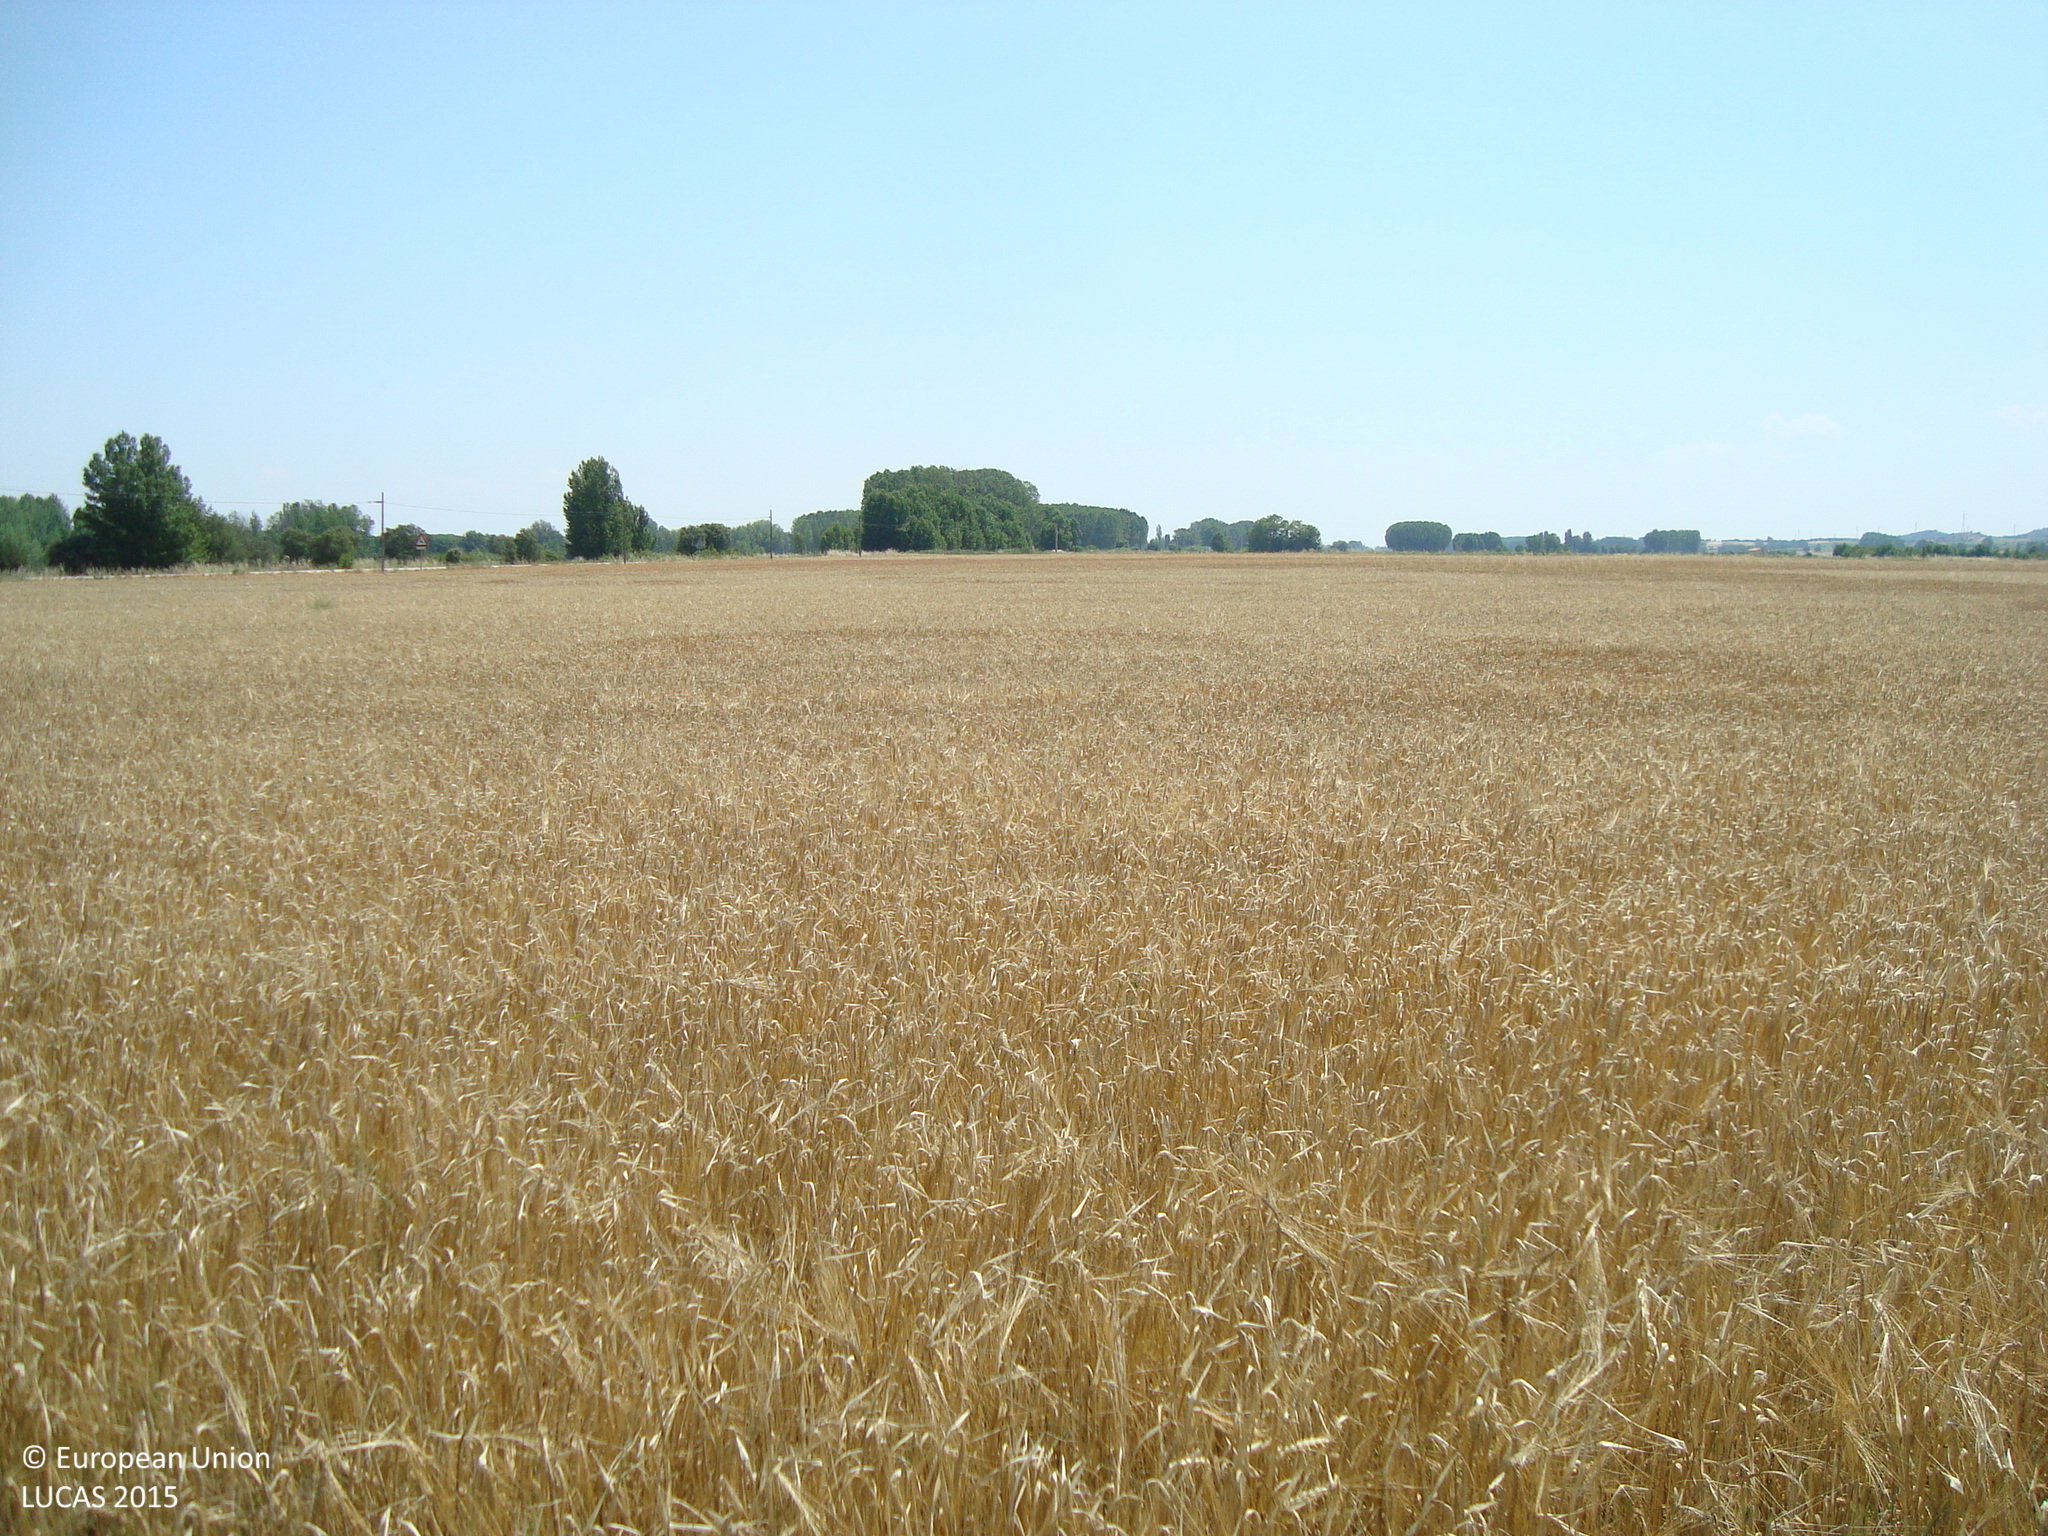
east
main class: Cropland
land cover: Barley
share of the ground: > 75 %
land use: Agriculture (excluding fallow land and kitchen gardens)
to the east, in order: Barley; Sugar beet
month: June
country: ES
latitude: 41.6668
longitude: -3.8063
